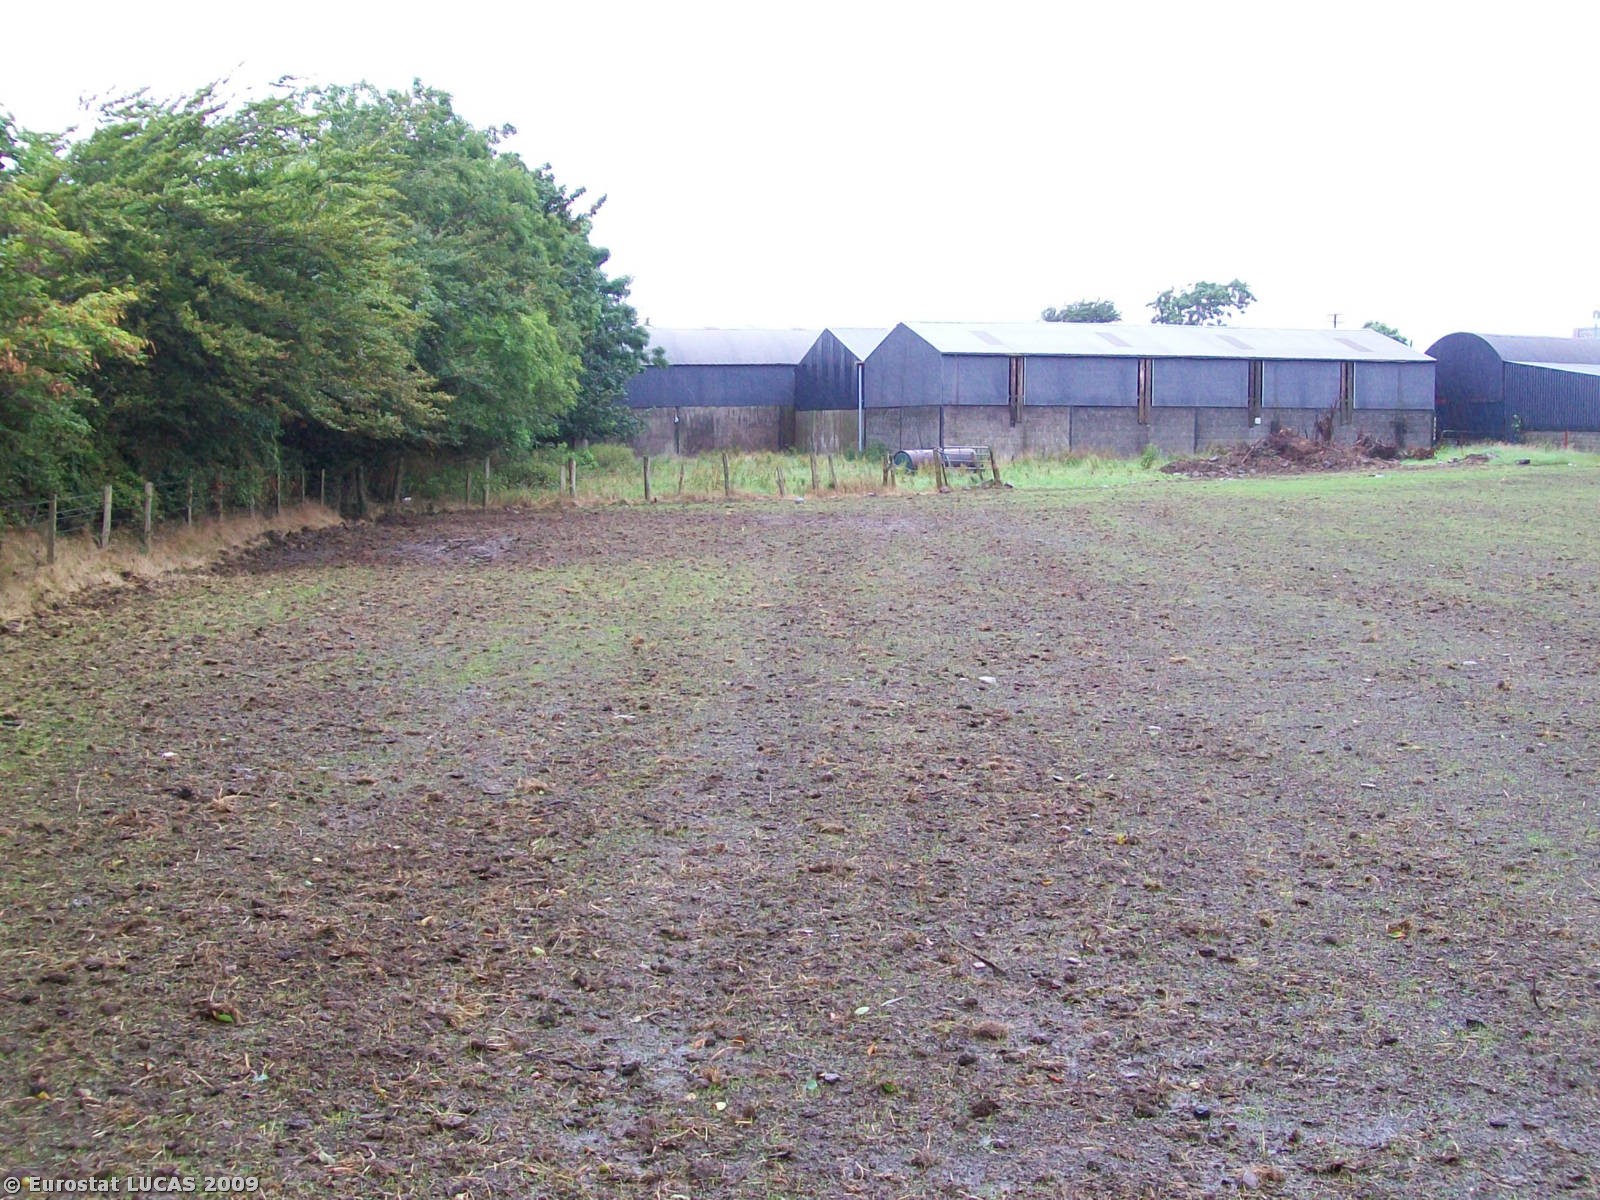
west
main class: Grassland
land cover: Grassland without tree/shrub cover
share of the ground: 10 - 25 %
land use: Agriculture (excluding fallow land and kitchen gardens)
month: July
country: GB
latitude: 54.8572
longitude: -6.1742
